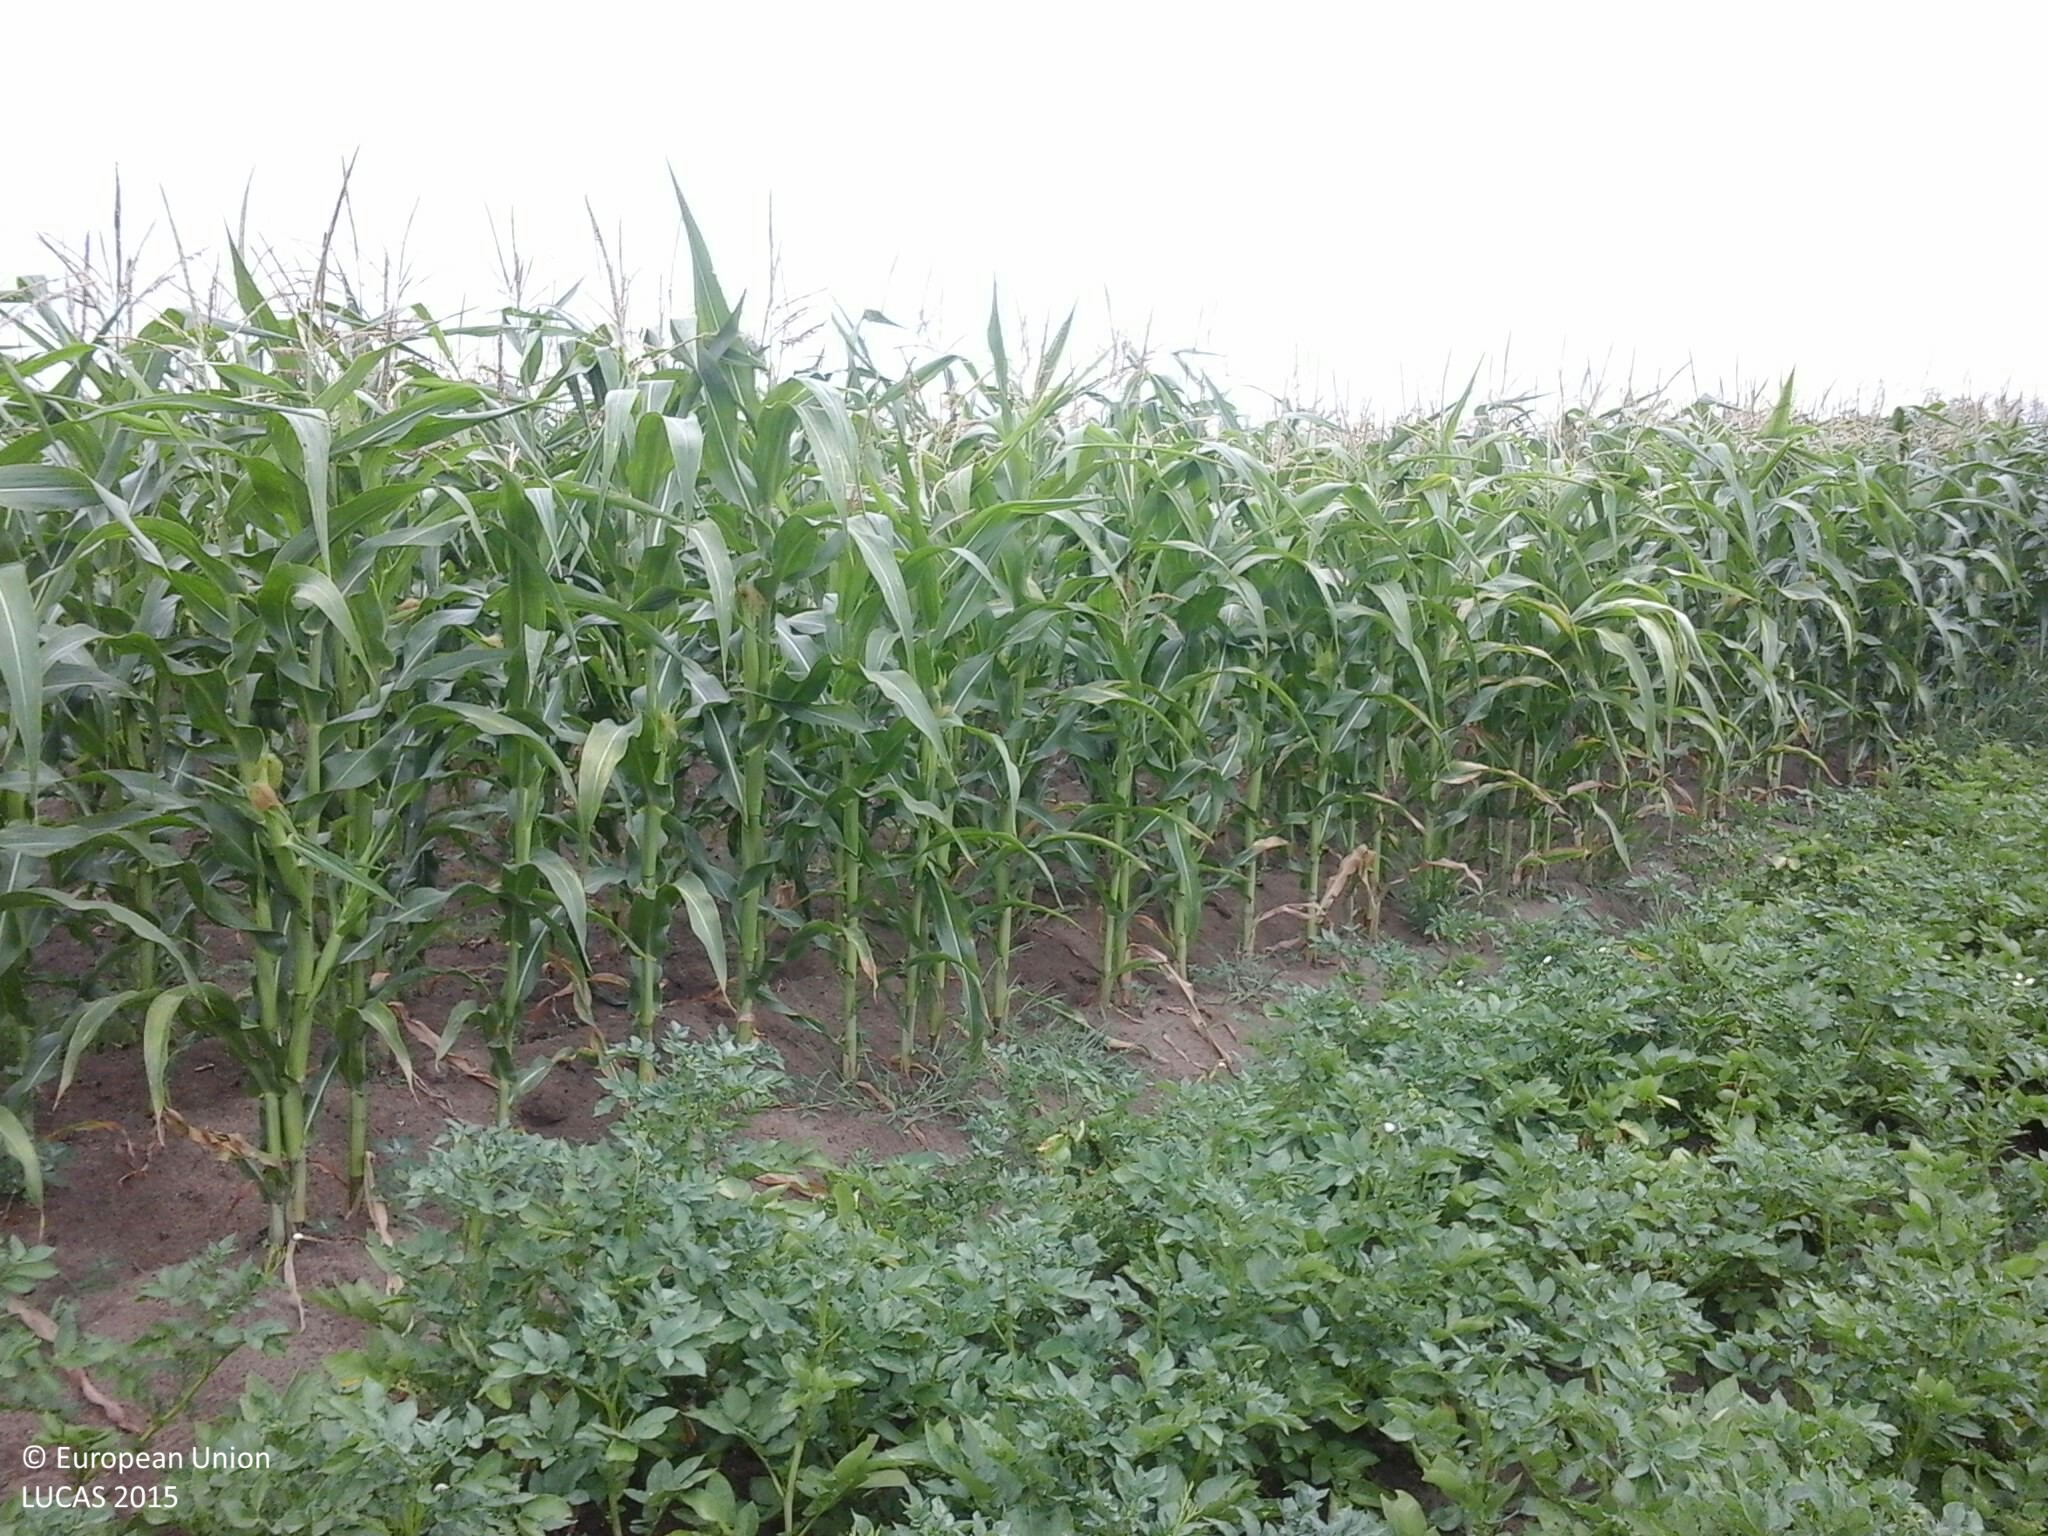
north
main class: Cropland
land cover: Potatoes
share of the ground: > 75 %
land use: Agriculture (excluding fallow land and kitchen gardens)
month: July
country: HU
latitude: 46.4766
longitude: 20.0379
